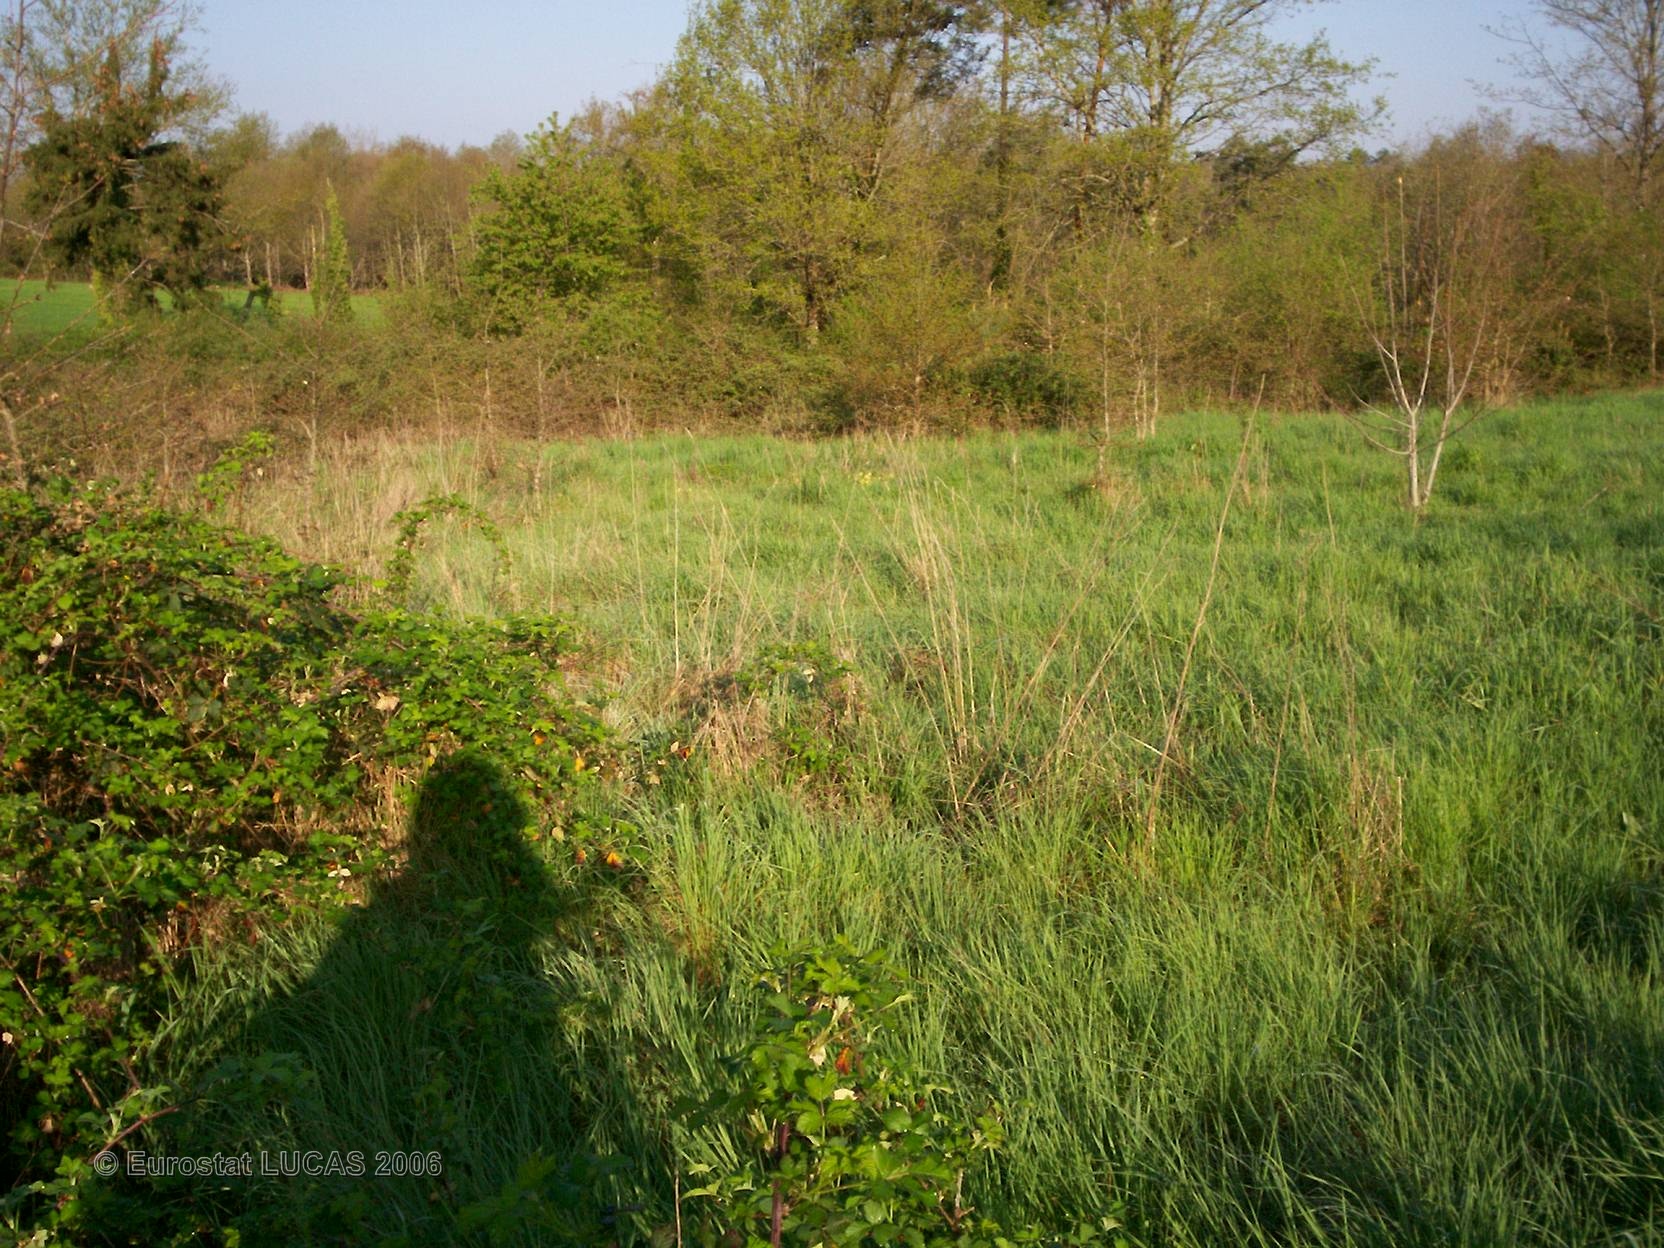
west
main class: Grassland
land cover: Grassland with sparse tree/shrub cover
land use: Unused
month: April
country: FR
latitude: 45.5198
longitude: 0.6037
